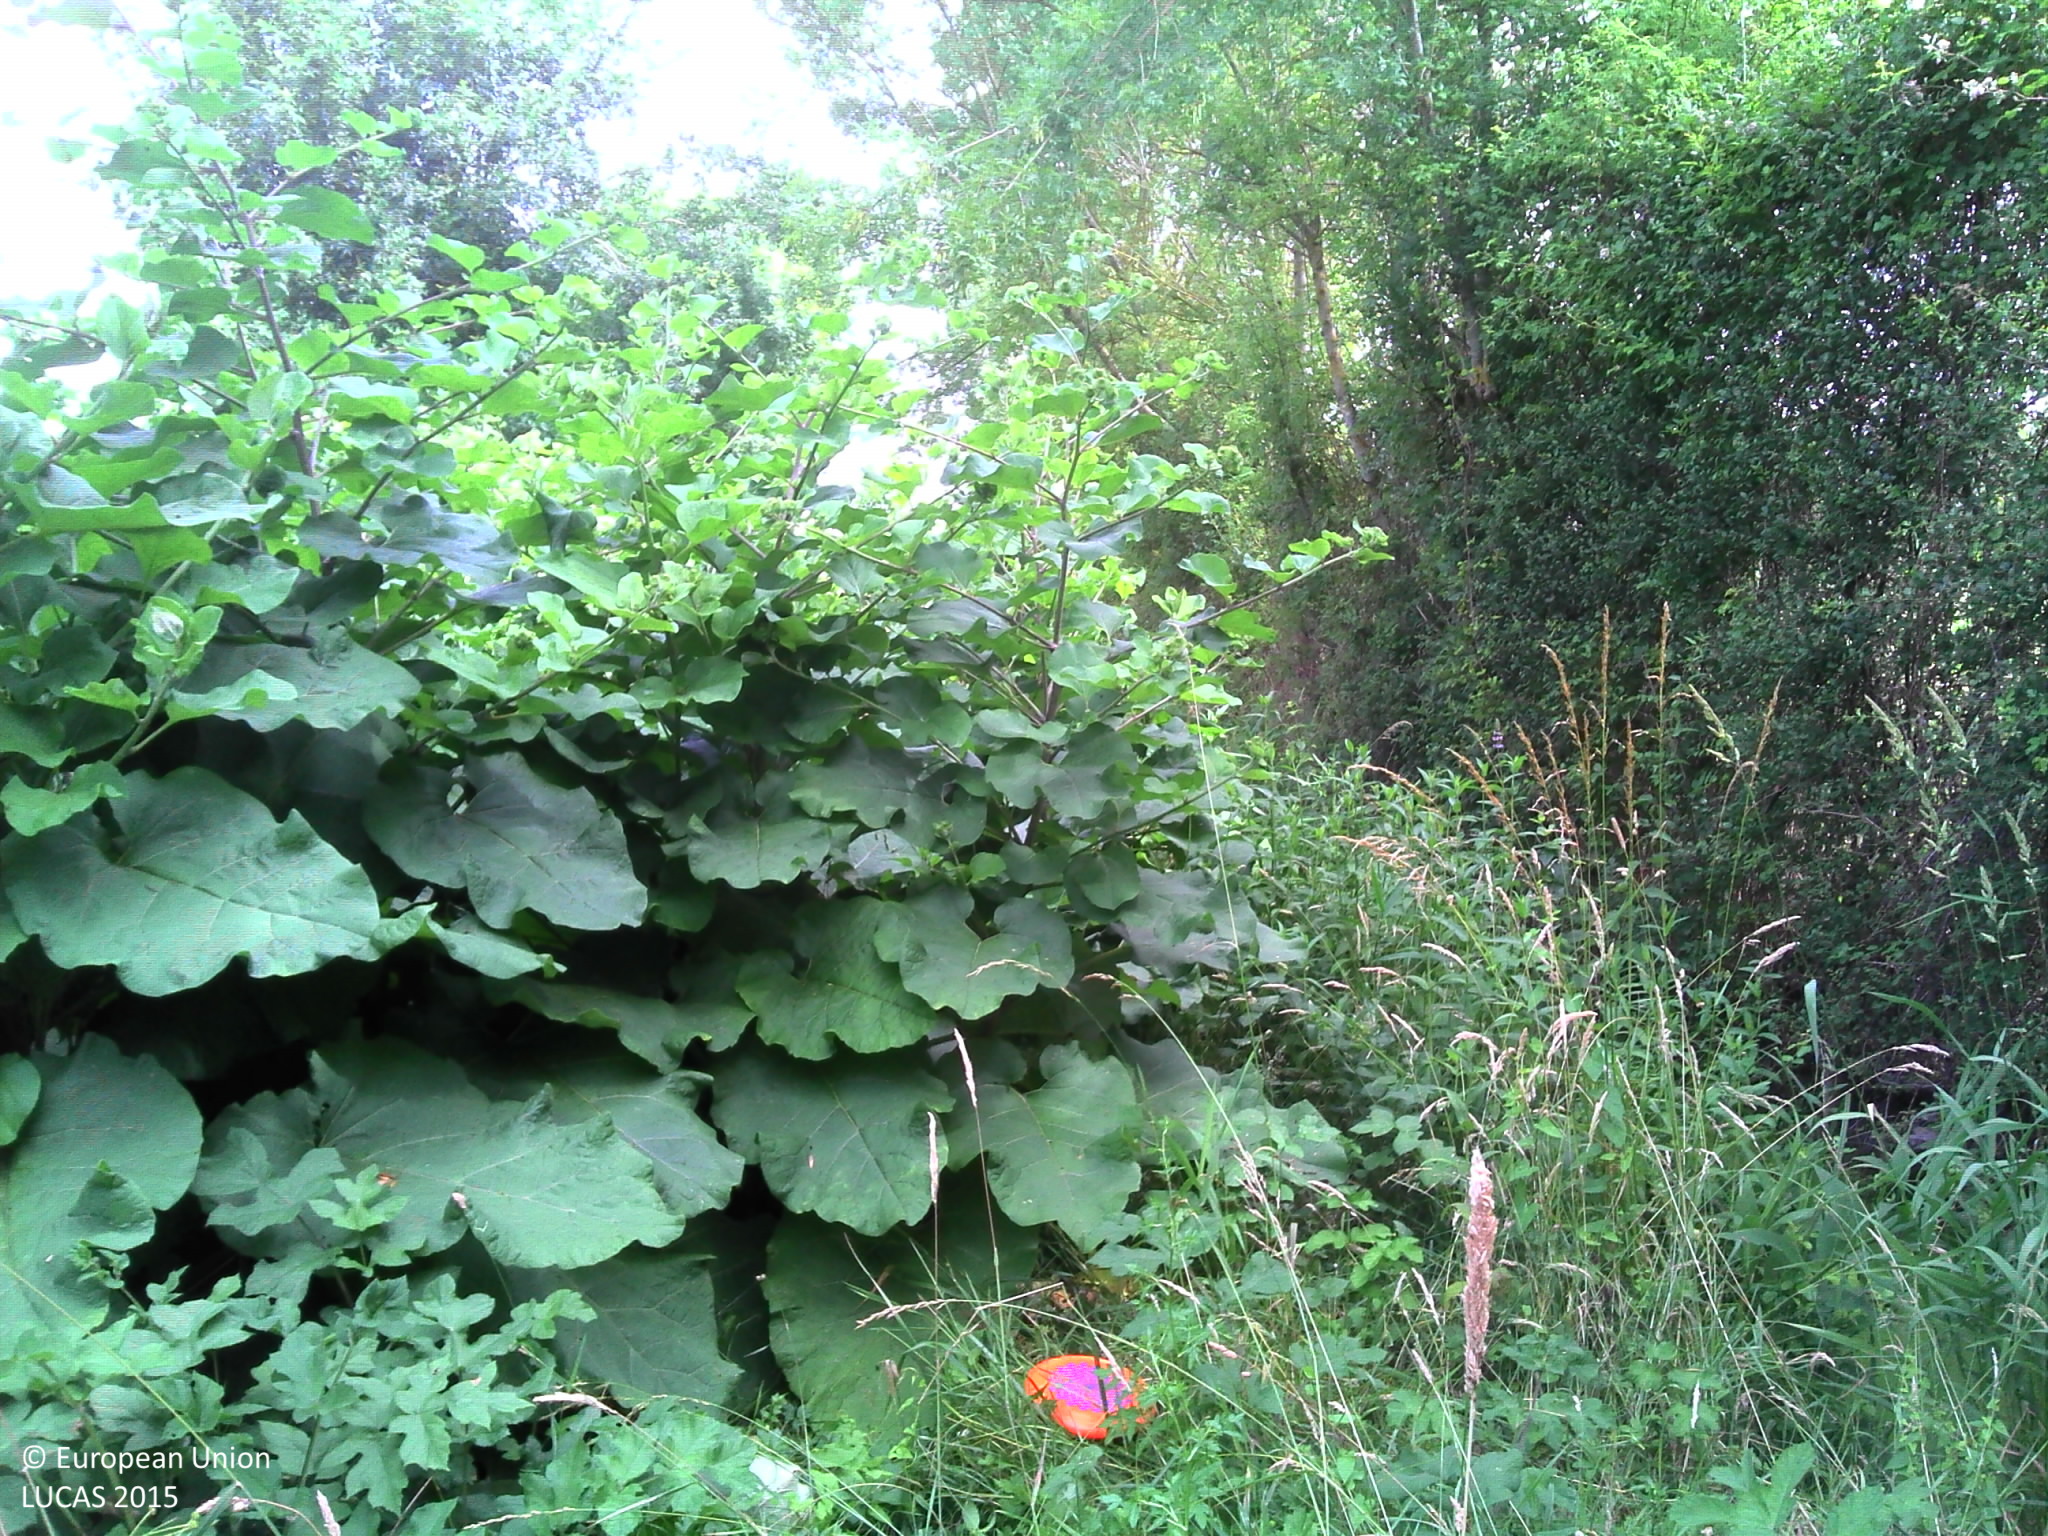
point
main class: Grassland
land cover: Grassland without tree/shrub cover
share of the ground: > 75 %
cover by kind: herbaceous plants 100 %
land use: Agriculture (excluding fallow land and kitchen gardens)
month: June
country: FR
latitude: 47.2646
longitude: 0.0499
